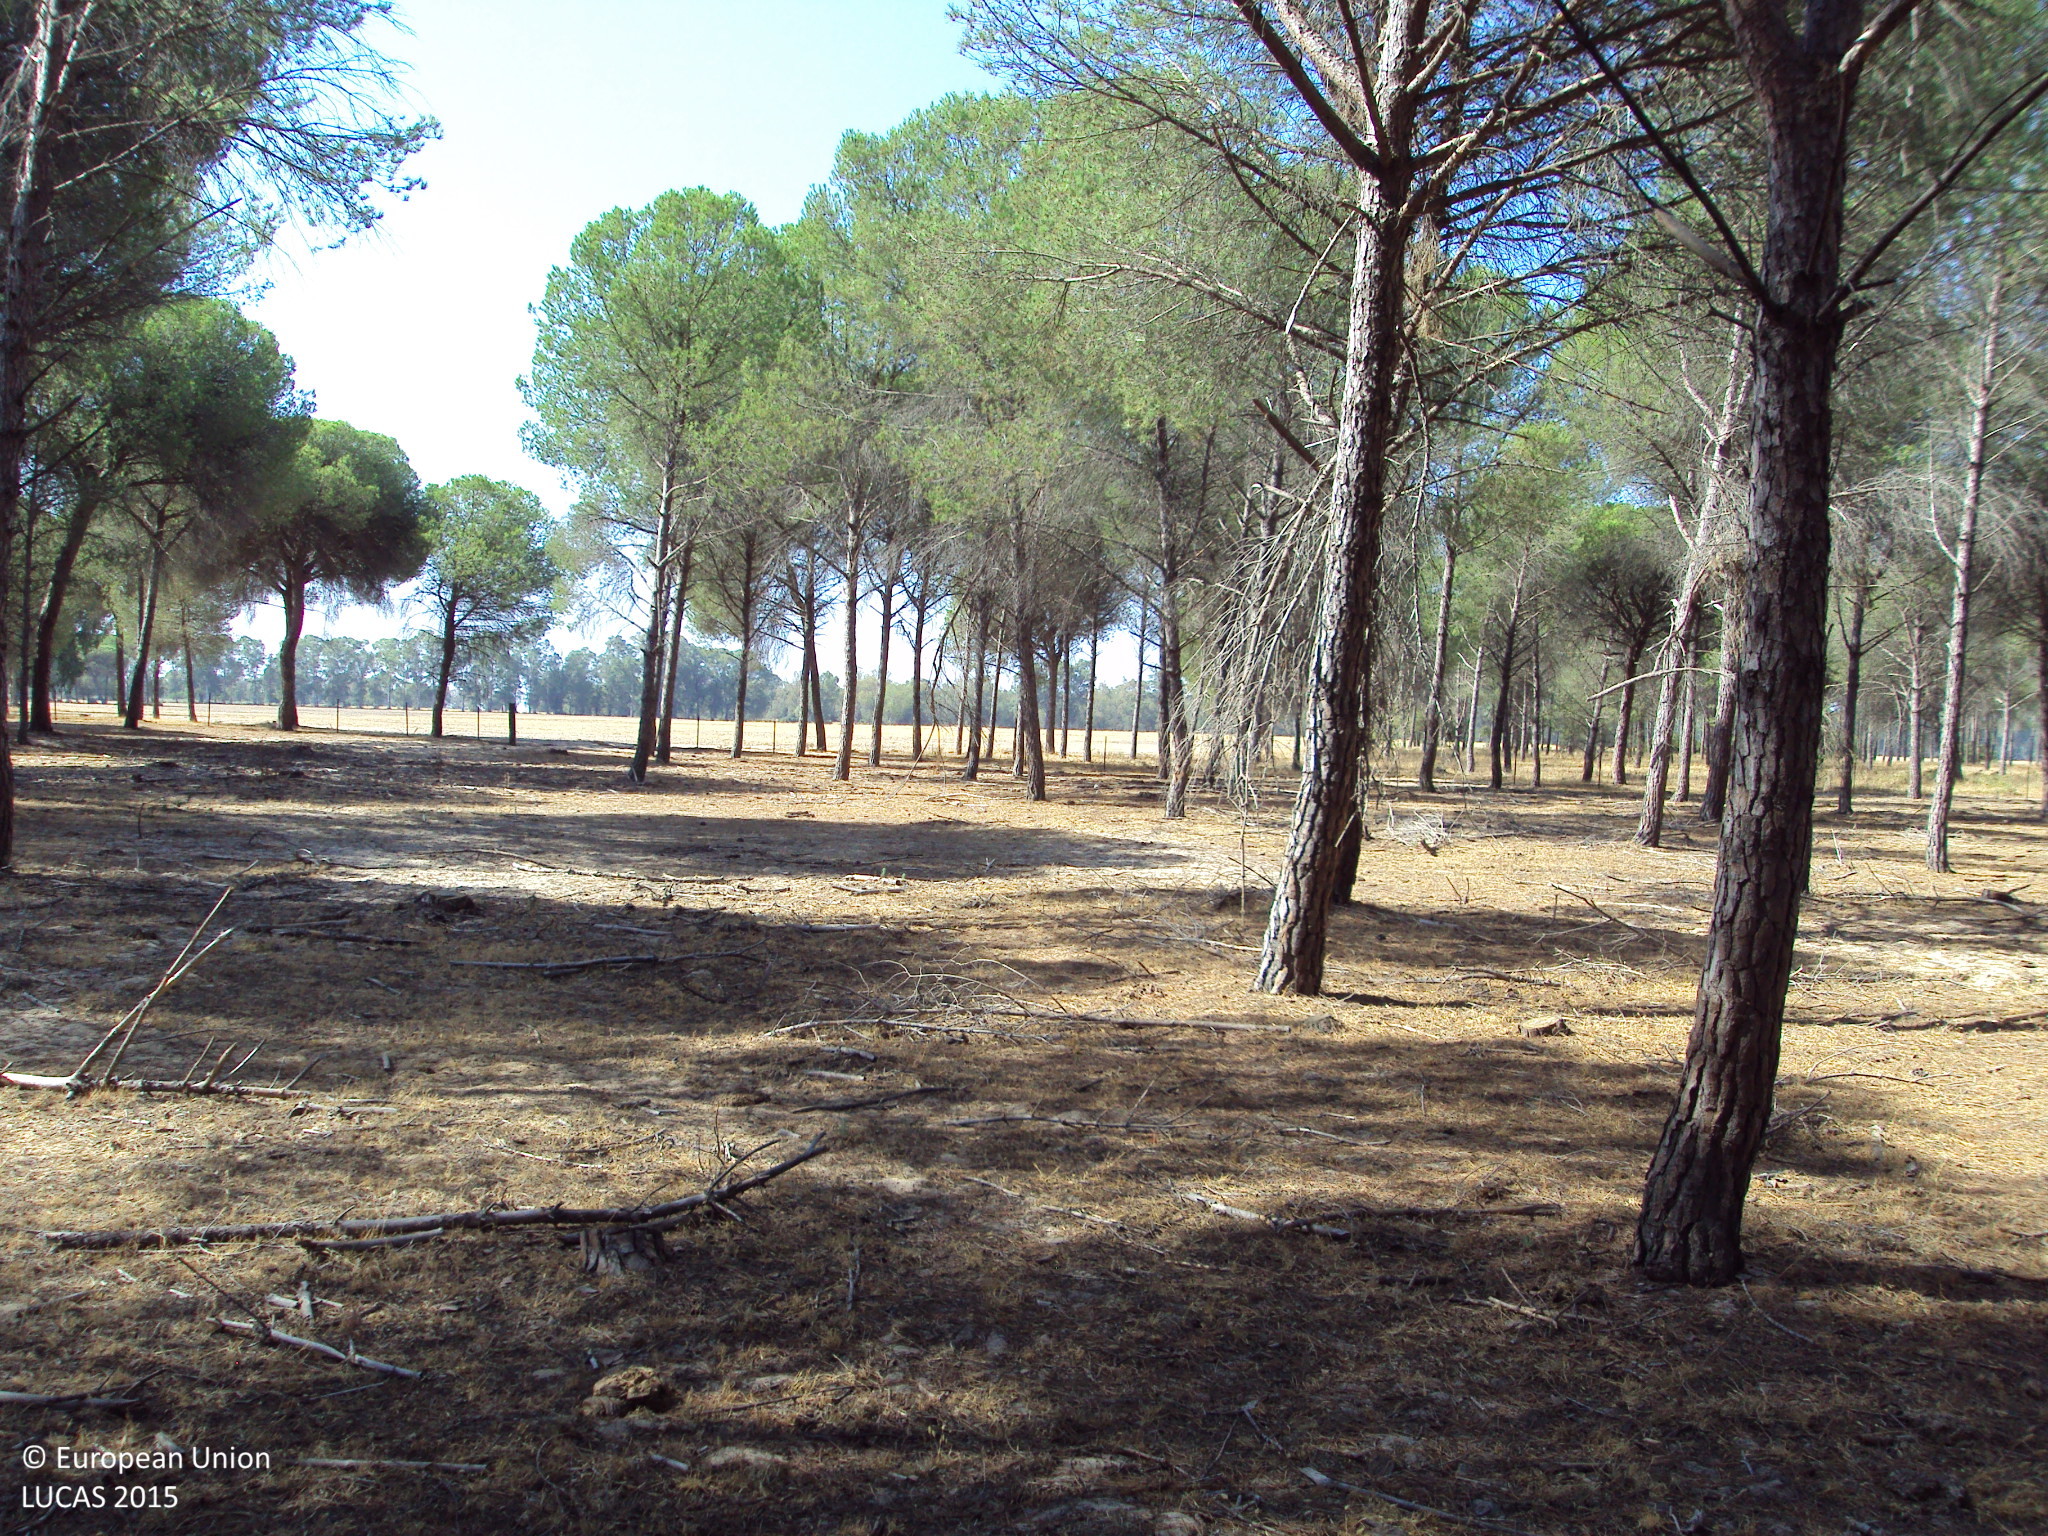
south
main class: Woodland
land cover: Pine dominated coniferous woodland
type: coniferous forest of the mediterranean region
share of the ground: > 75 %
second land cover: Spontaneously vegetated surfaces
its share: 25 - 50 %
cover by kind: coniferous forest trees 95 %, herbaceous plants 5 %
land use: Forestry
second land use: Agriculture (excluding fallow land and kitchen gardens)
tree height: > 5 m
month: August
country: ES
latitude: 37.1680
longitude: -6.3667
